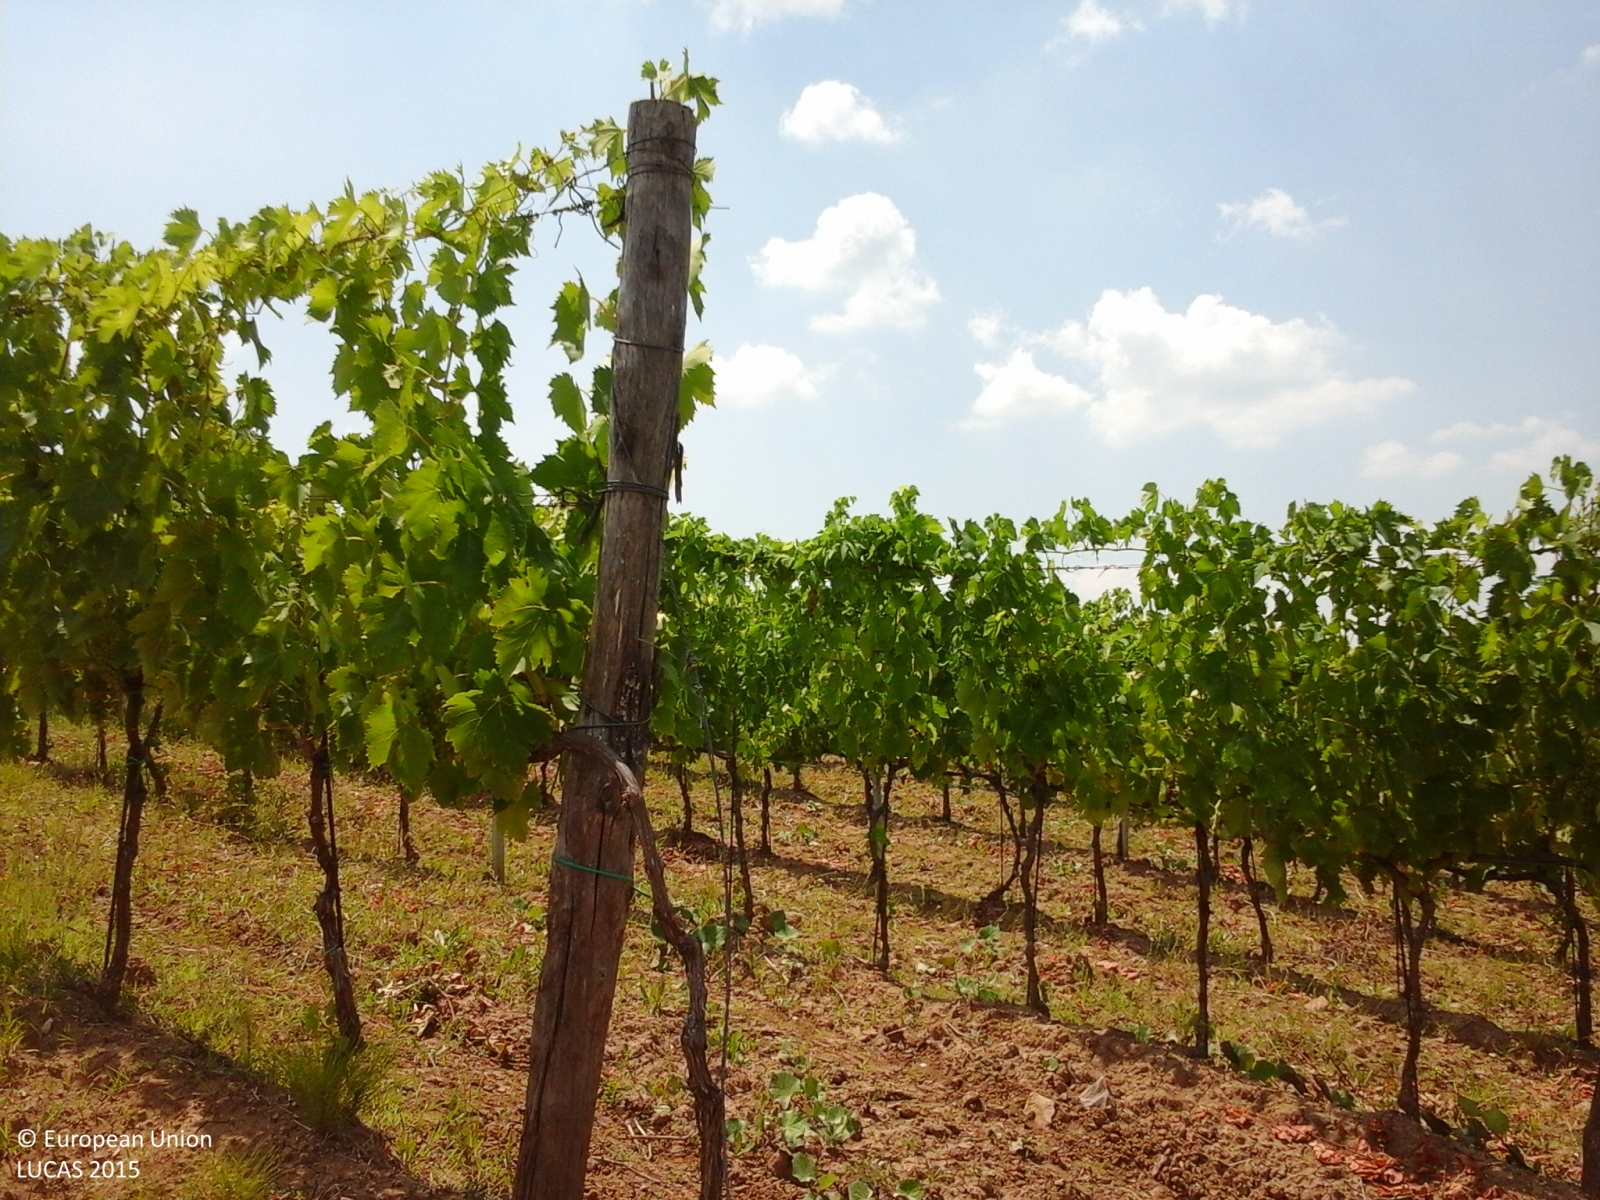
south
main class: Cropland
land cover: Vineyards
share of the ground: 25 - 50 %
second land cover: Grassland without tree/shrub cover
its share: > 75 %
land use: Agriculture (excluding fallow land and kitchen gardens)
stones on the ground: < 10 %
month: June
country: IT
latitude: 43.5503
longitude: 11.1480
